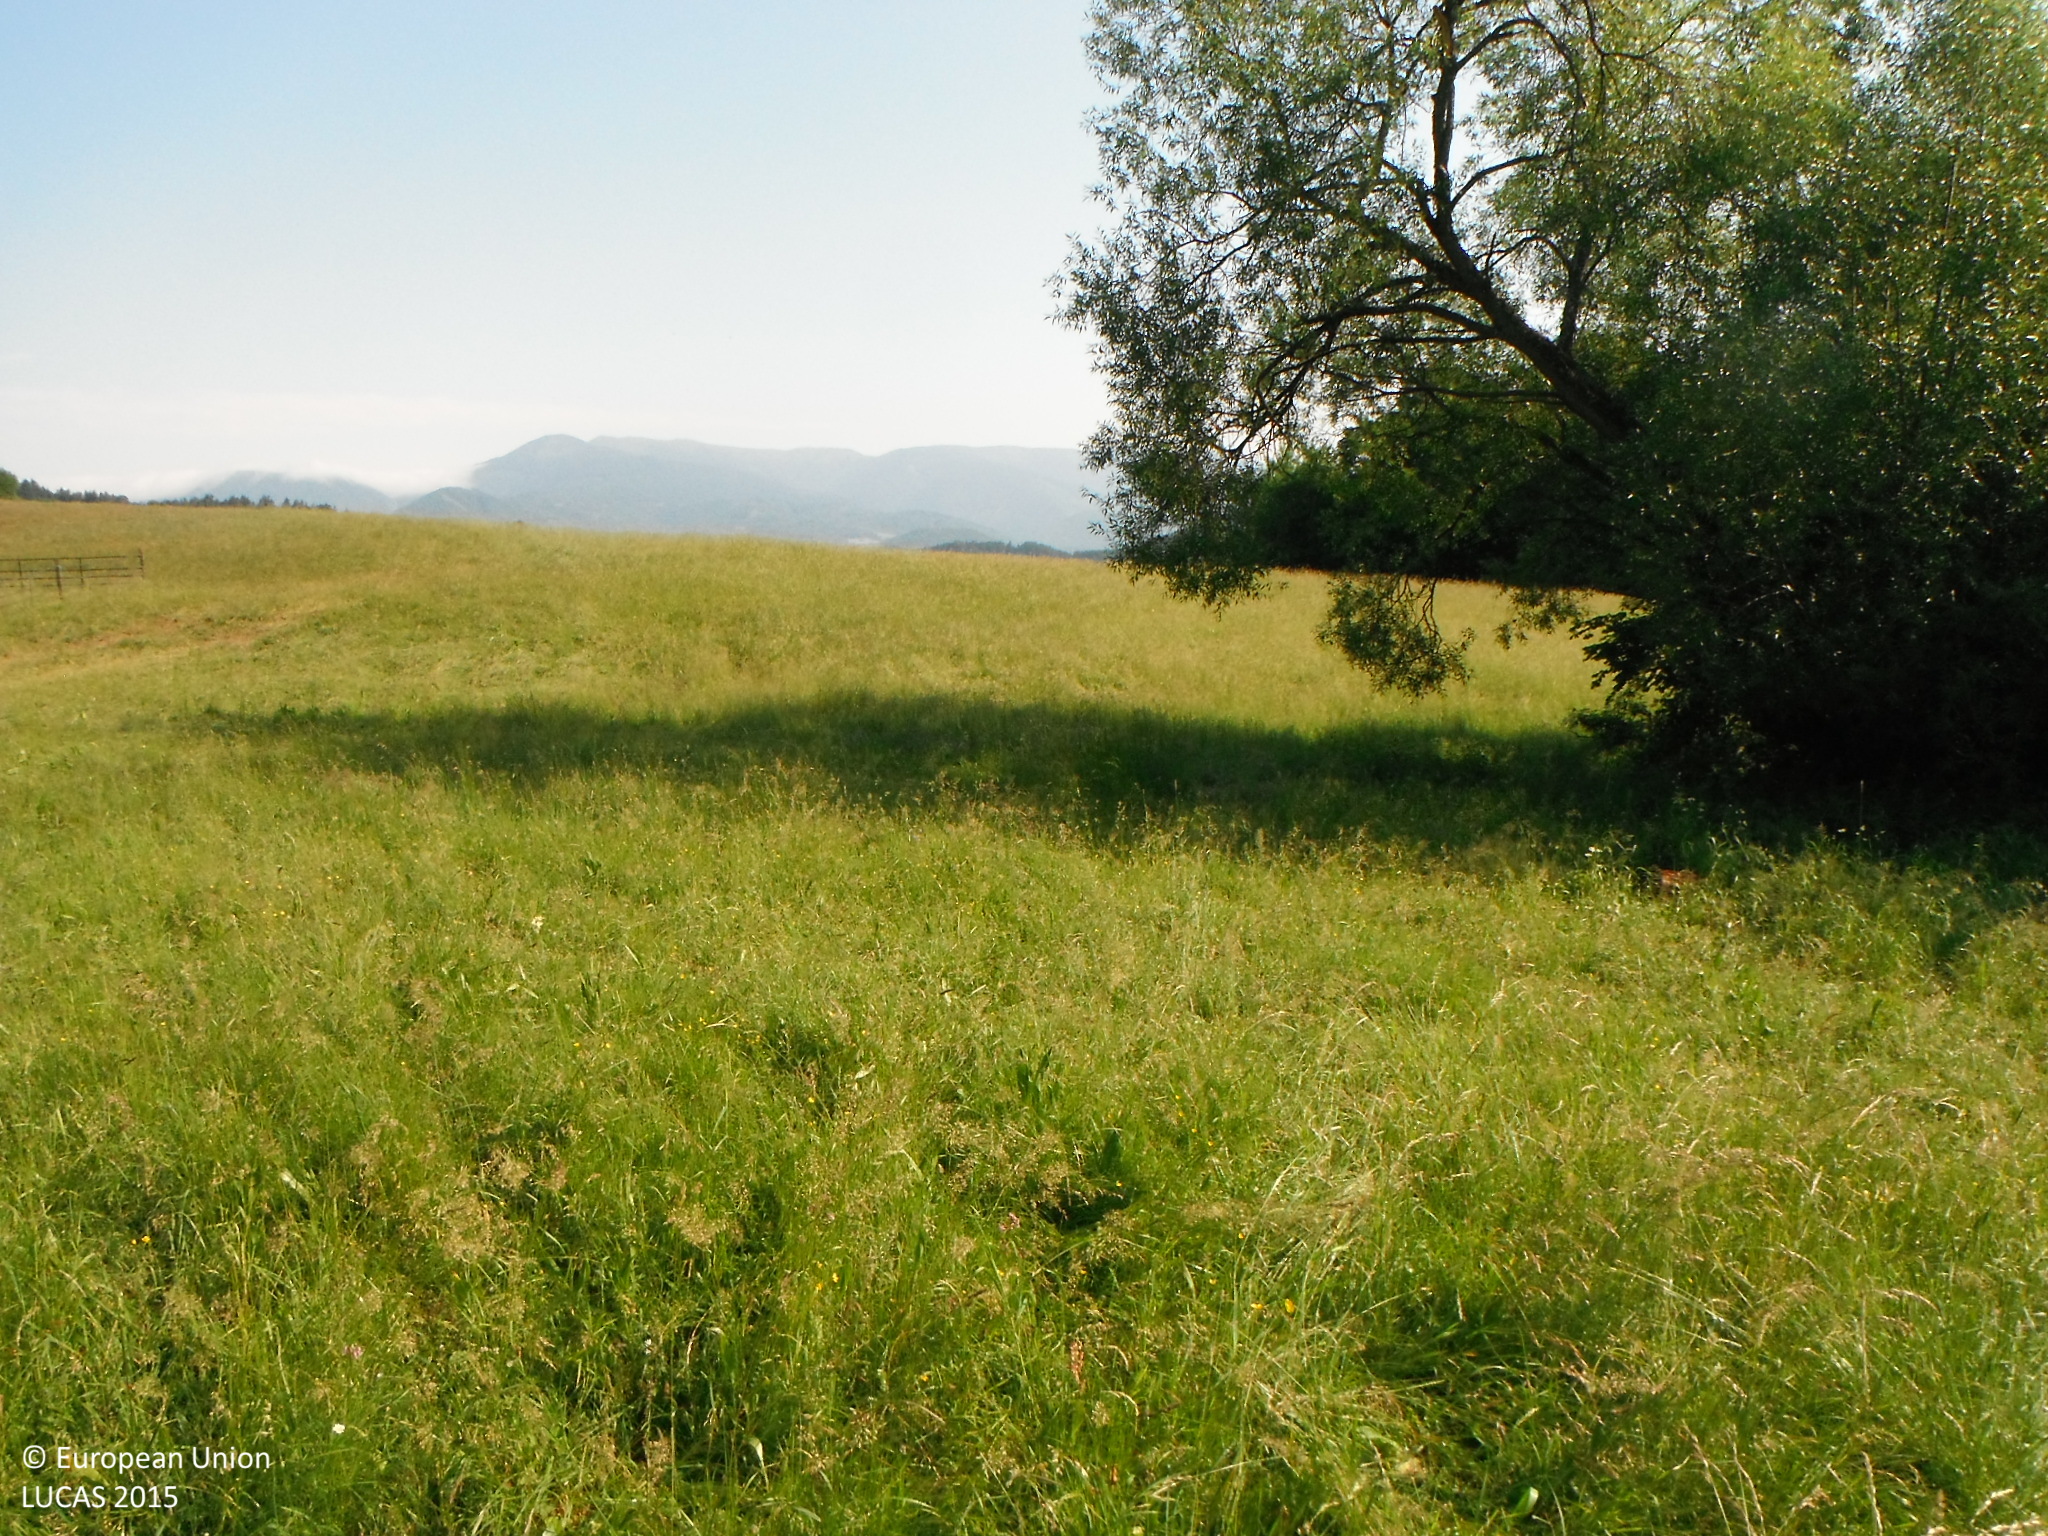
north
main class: Grassland
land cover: Grassland without tree/shrub cover
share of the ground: > 75 %
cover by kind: herbaceous plants 100 %
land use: Agriculture (excluding fallow land and kitchen gardens)
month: June
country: SK
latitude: 48.7499
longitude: 19.3405
